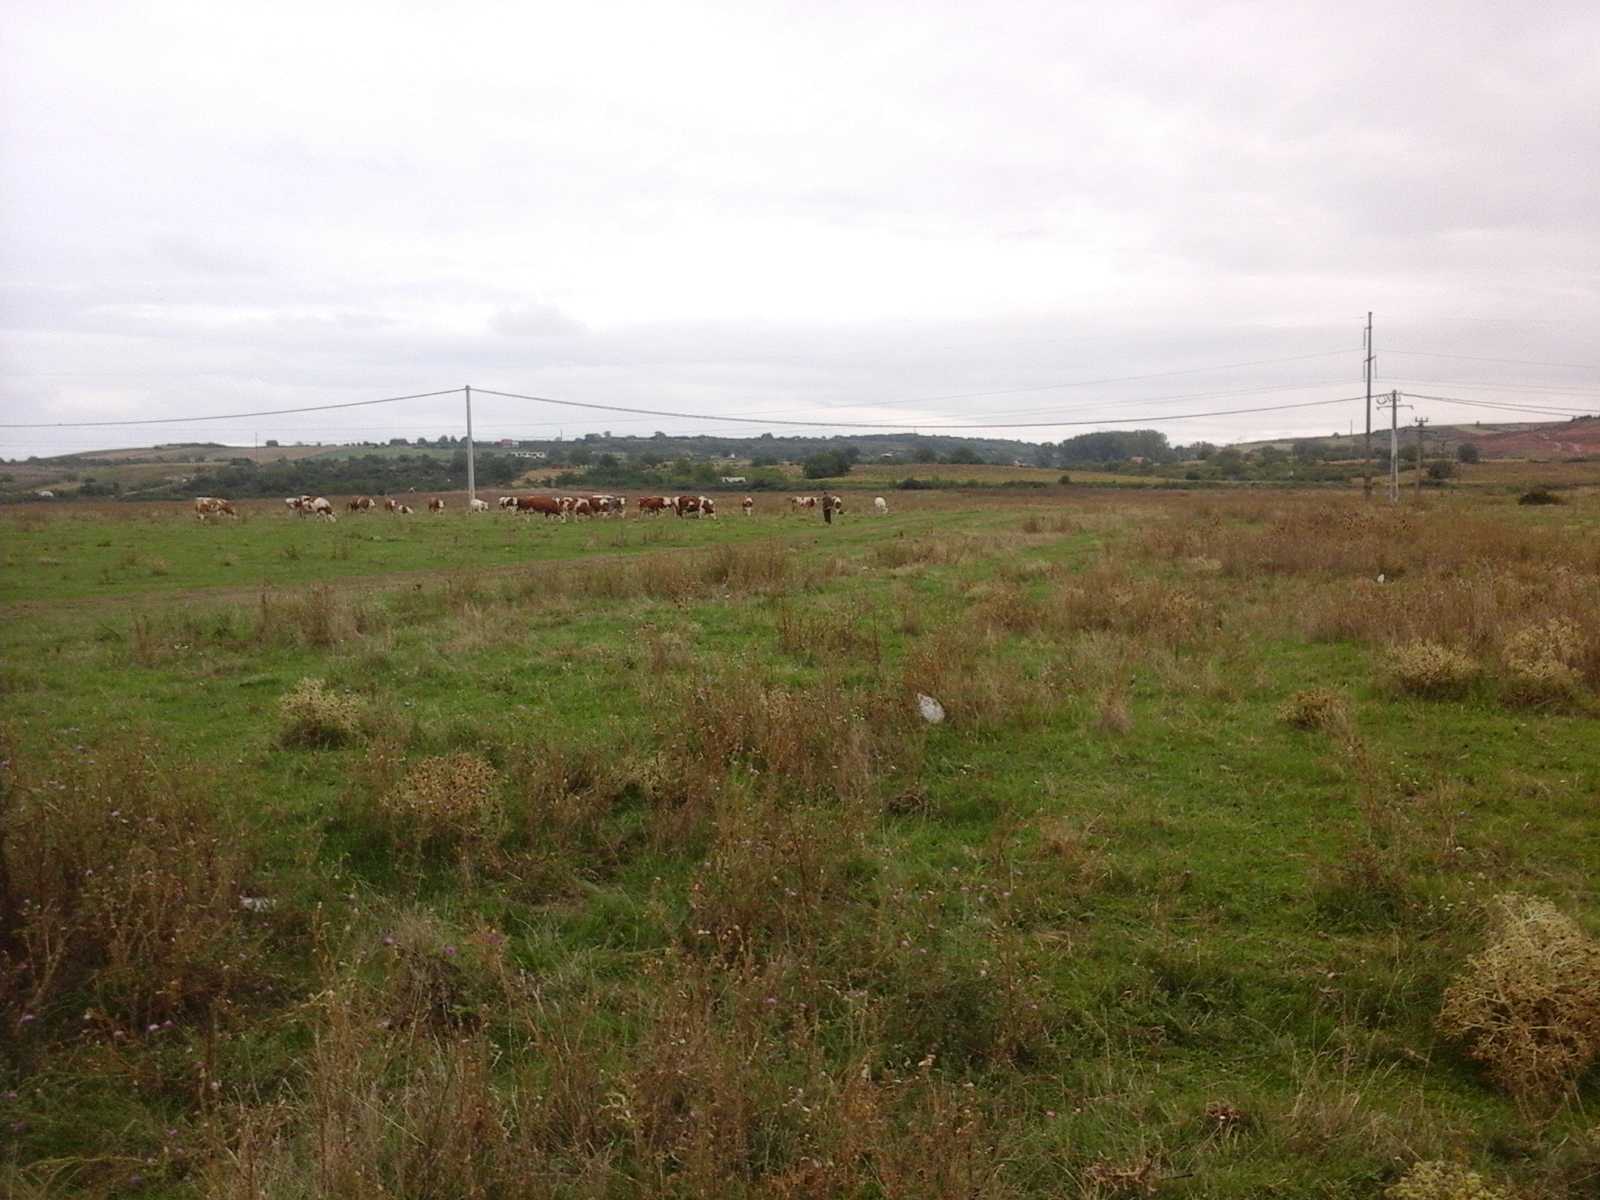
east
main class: Grassland
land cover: Spontaneously vegetated surfaces
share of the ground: > 75 %
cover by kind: herbaceous plants 100 %
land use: Agriculture (excluding fallow land and kitchen gardens)
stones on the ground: < 10 %
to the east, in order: Spontaneously vegetated surfaces; Tracks; Spontaneously vegetated surfaces; Electric lines; Spontaneously vegetated surfaces
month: September
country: RO
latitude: 47.1547
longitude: 21.9303
